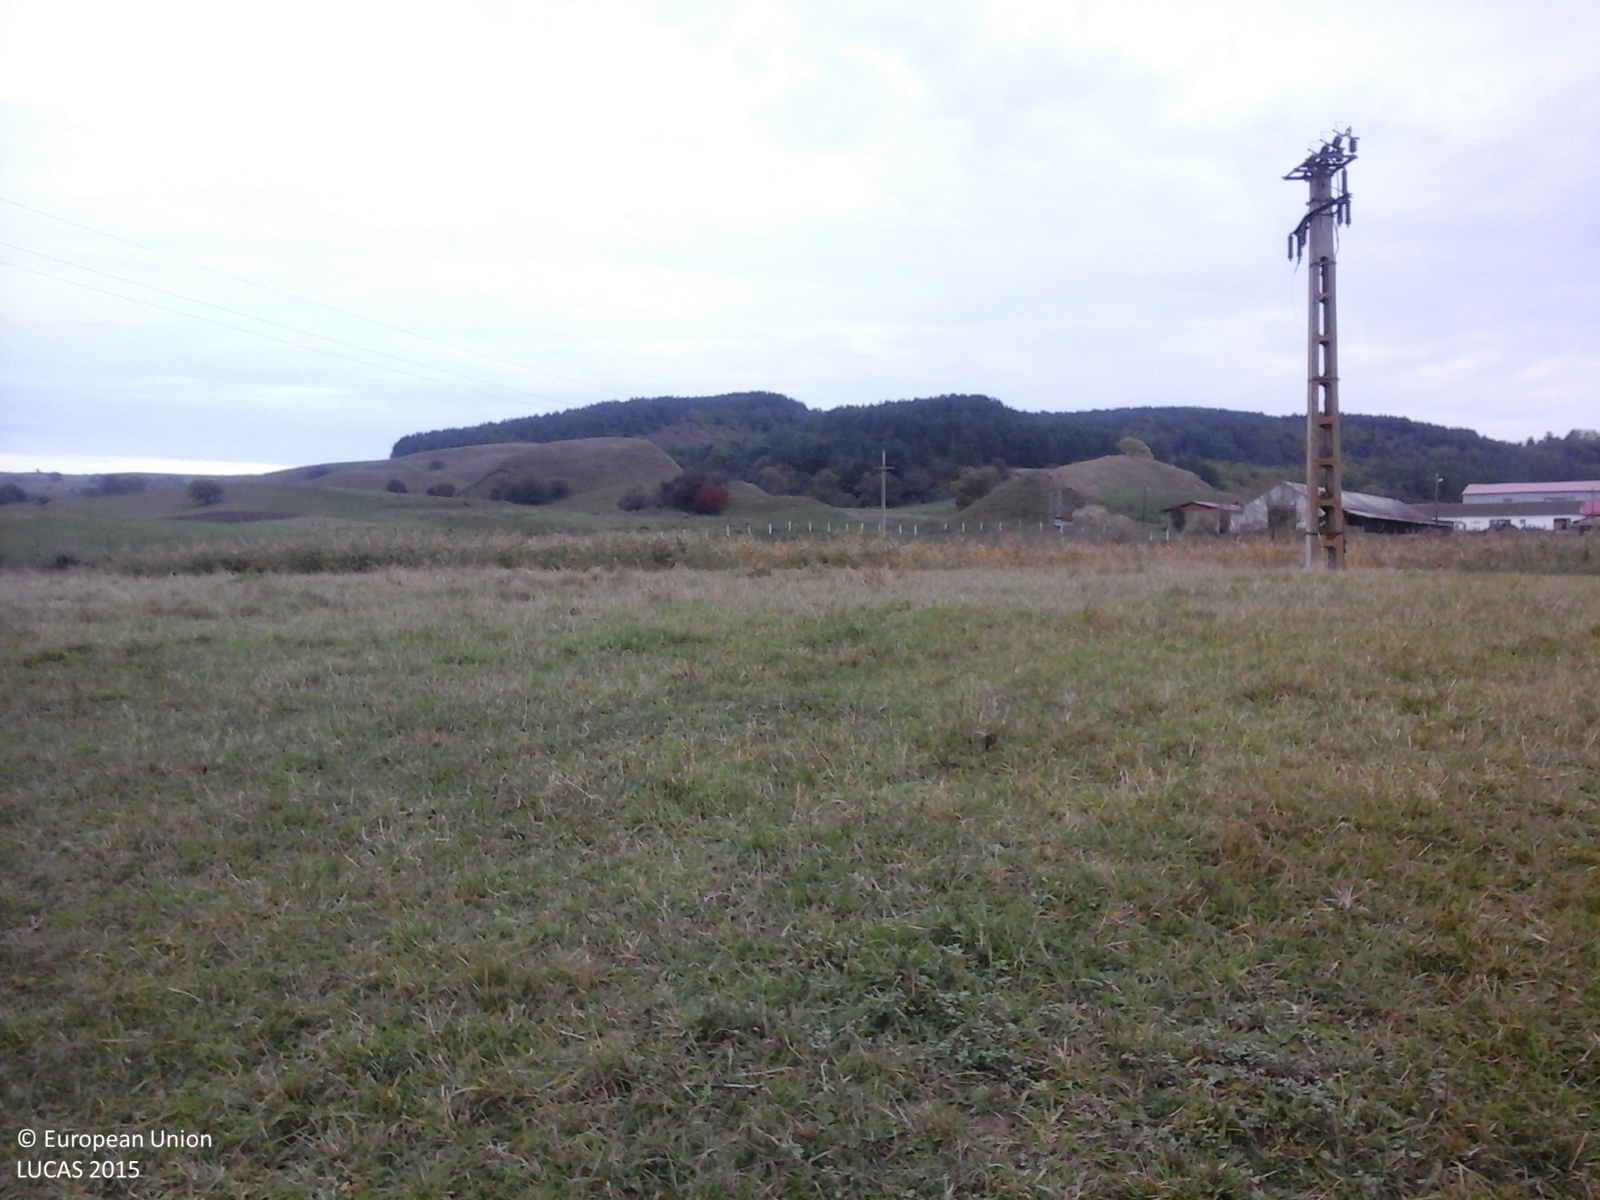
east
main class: Grassland
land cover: Grassland without tree/shrub cover
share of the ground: > 75 %
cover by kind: herbaceous plants 100 %
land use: Agriculture (excluding fallow land and kitchen gardens)
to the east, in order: Grassland without tree/shrub cover; Electric lines; Grassland without tree/shrub cover; Maize; Inland marshes; Electric lines; Inland marshes; Electric lines; Tracks; Grass margins; Fences; Other fresh vegetables
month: October
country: RO
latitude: 46.0309
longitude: 24.9108
